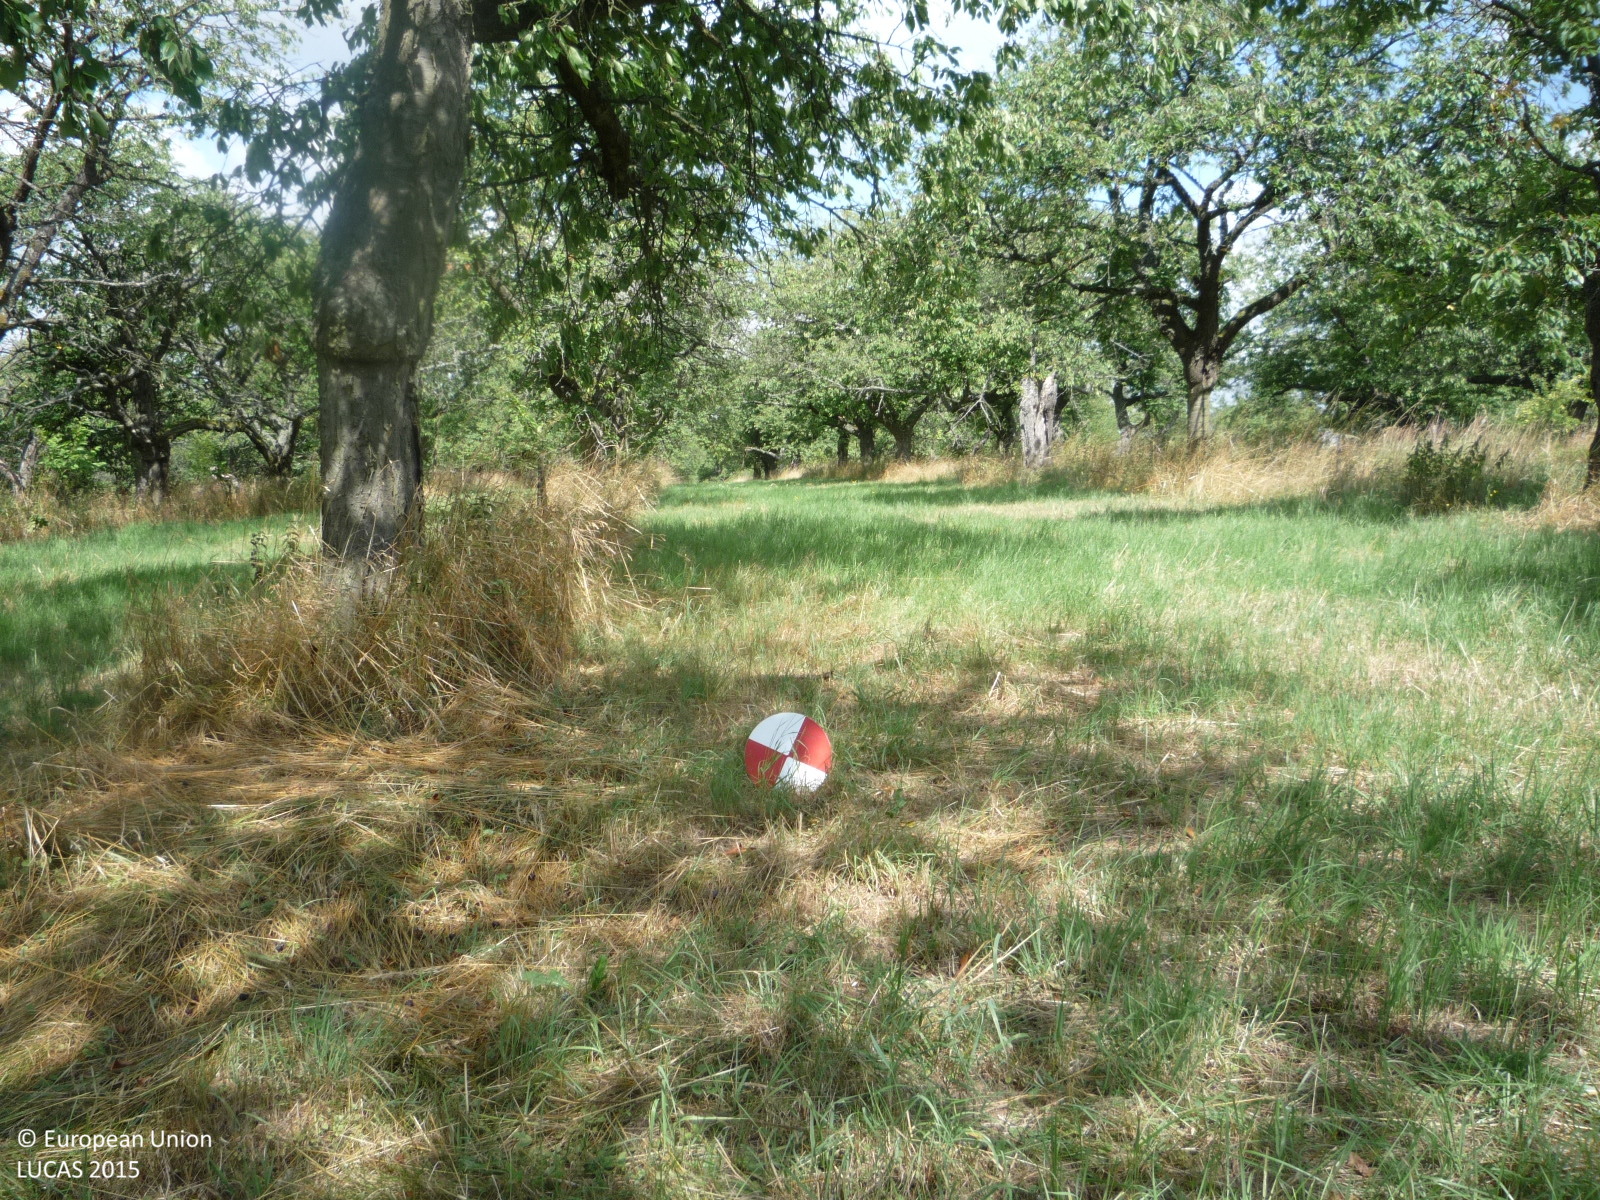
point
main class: Cropland
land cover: Cherry fruit
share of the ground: 50 - 75 %
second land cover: Grassland without tree/shrub cover
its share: 25 - 50 %
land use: Agriculture (excluding fallow land and kitchen gardens)
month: July
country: CZ
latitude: 50.4978
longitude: 15.2054
